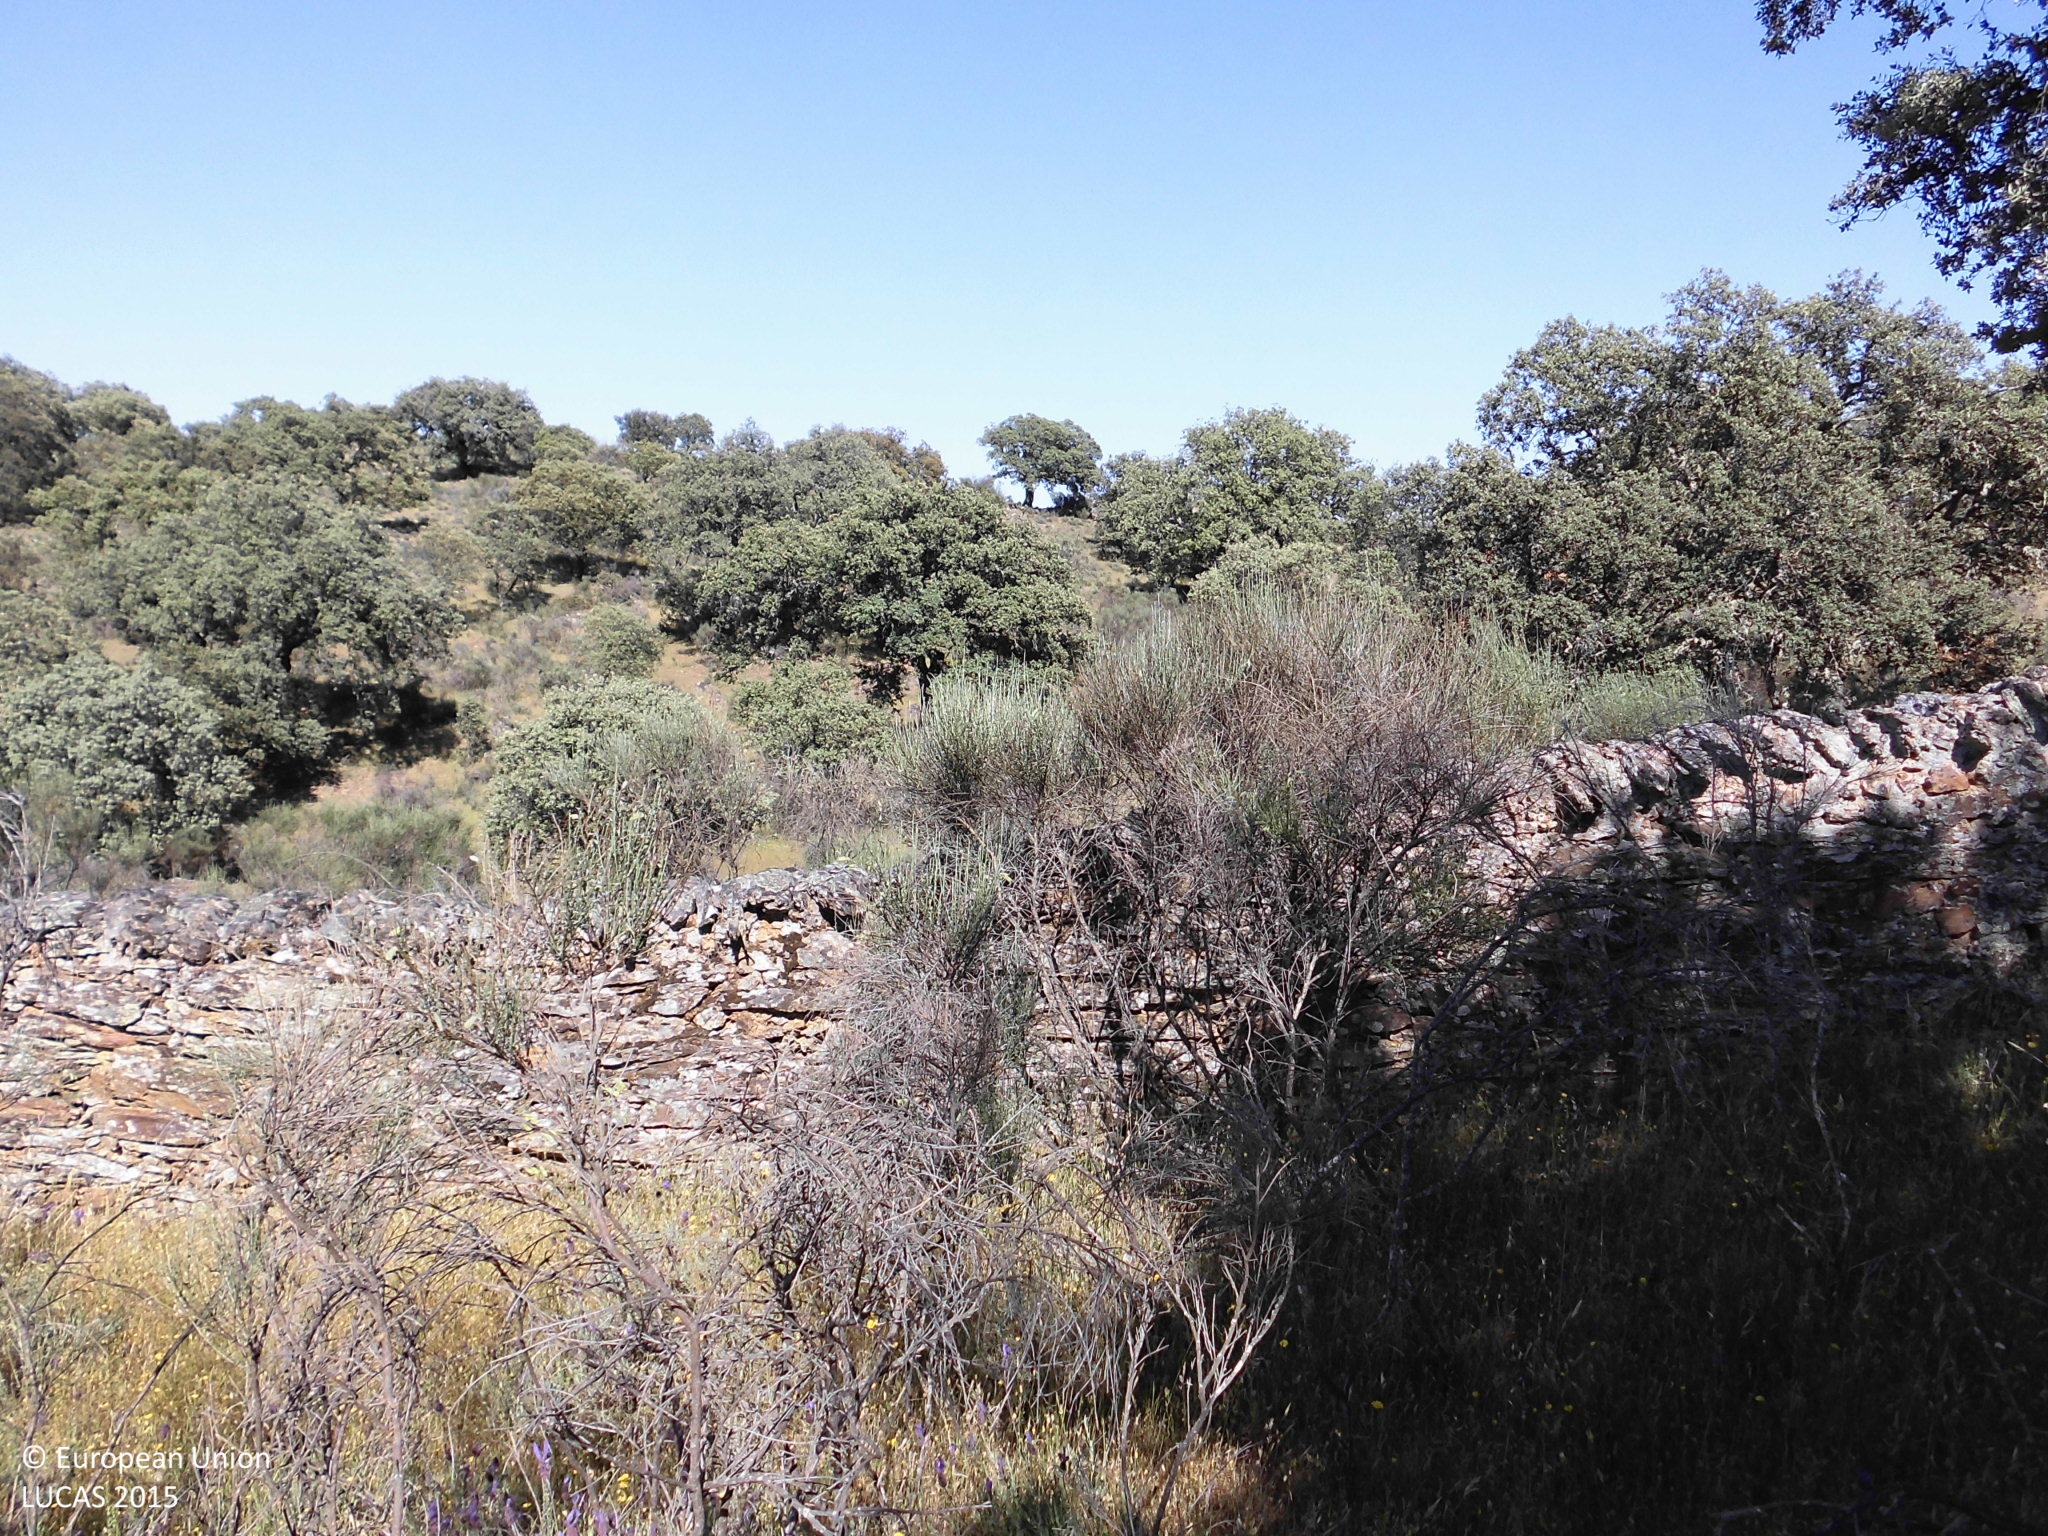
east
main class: Woodland
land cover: Broadleaved woodland
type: broadleaved evergreen forest
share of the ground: 25 - 50 %
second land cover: Shrubland without tree cover
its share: > 75 %
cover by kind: herbaceous plants 50 %, broadleaved forest trees 30 %, shrubs 20 %
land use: Forestry
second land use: Agriculture (excluding fallow land and kitchen gardens)
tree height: > 5 m
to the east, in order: Broadleaved woodland; Shrubland without tree cover; Dry stone walls; Broadleaved woodland; Tracks; Broadleaved woodland; Dry stone walls
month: May
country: ES
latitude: 39.5339
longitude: -6.1078
